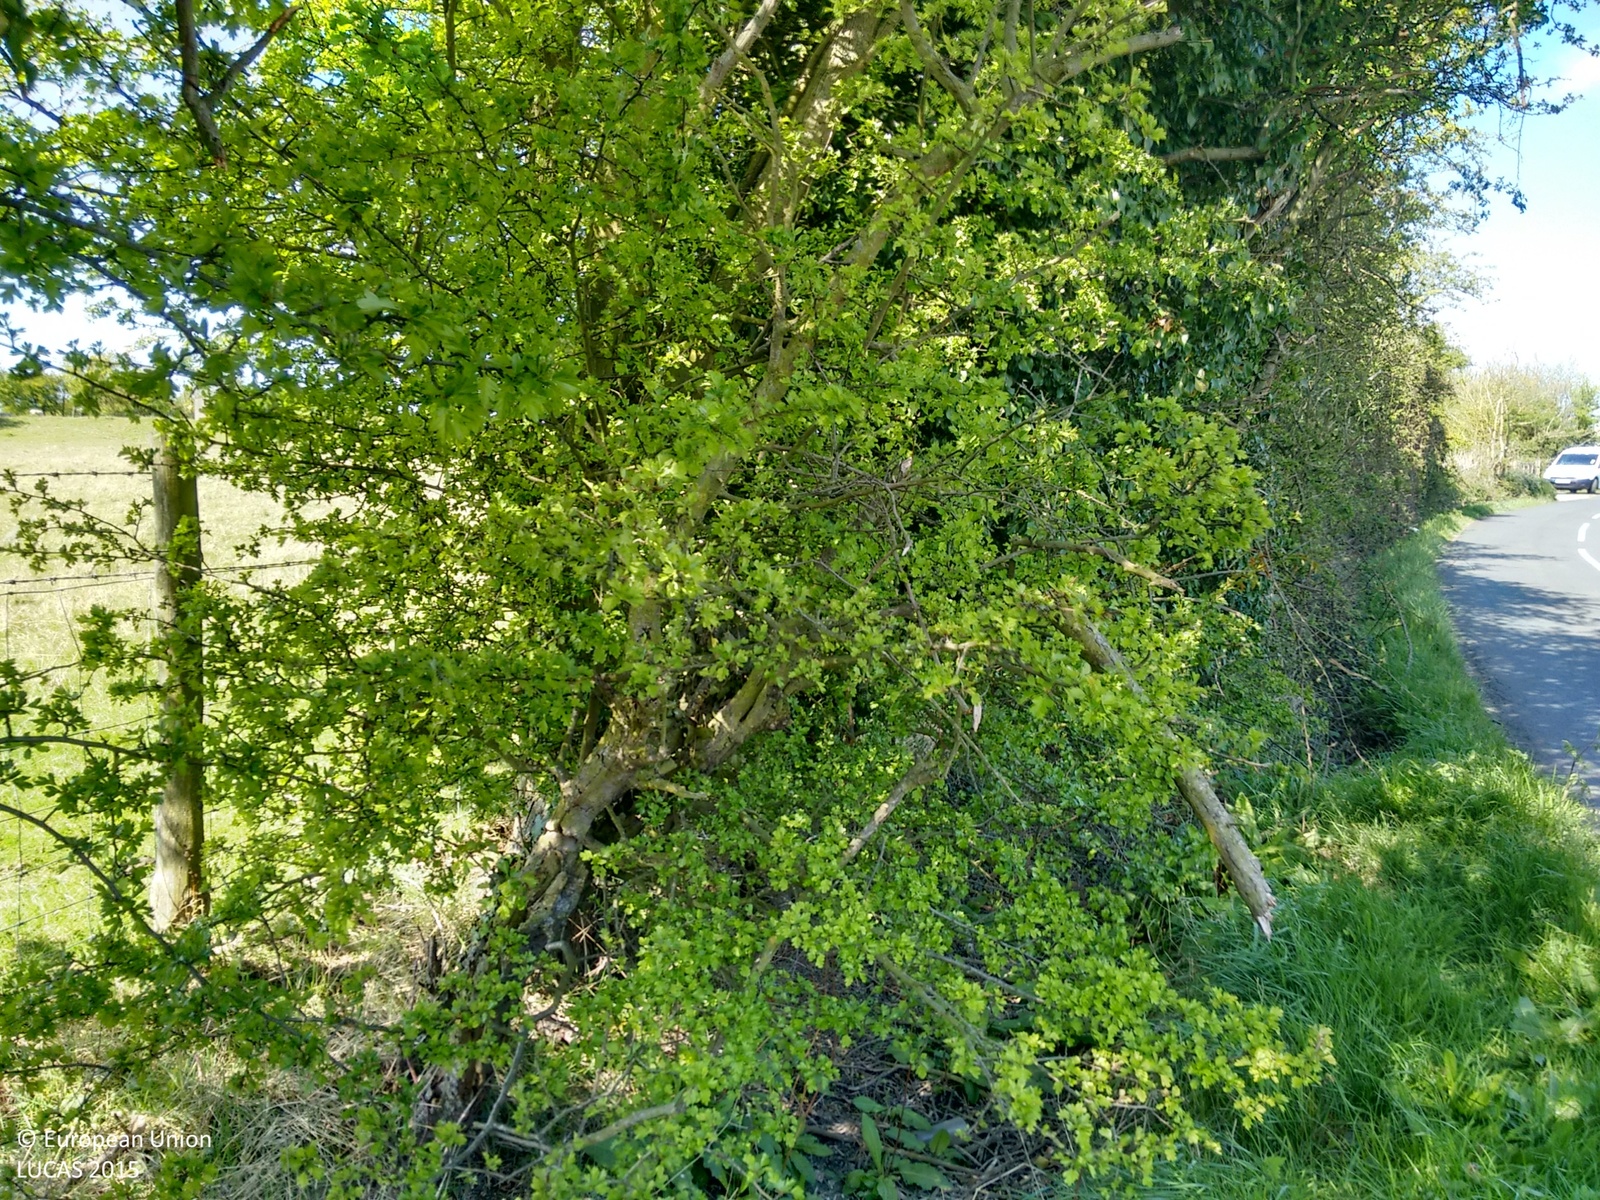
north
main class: Grassland
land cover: Grassland without tree/shrub cover
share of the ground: > 75 %
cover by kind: herbaceous plants 100 %
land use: Agriculture (excluding fallow land and kitchen gardens)
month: April
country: GB
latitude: 51.4385
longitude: 0.5497
